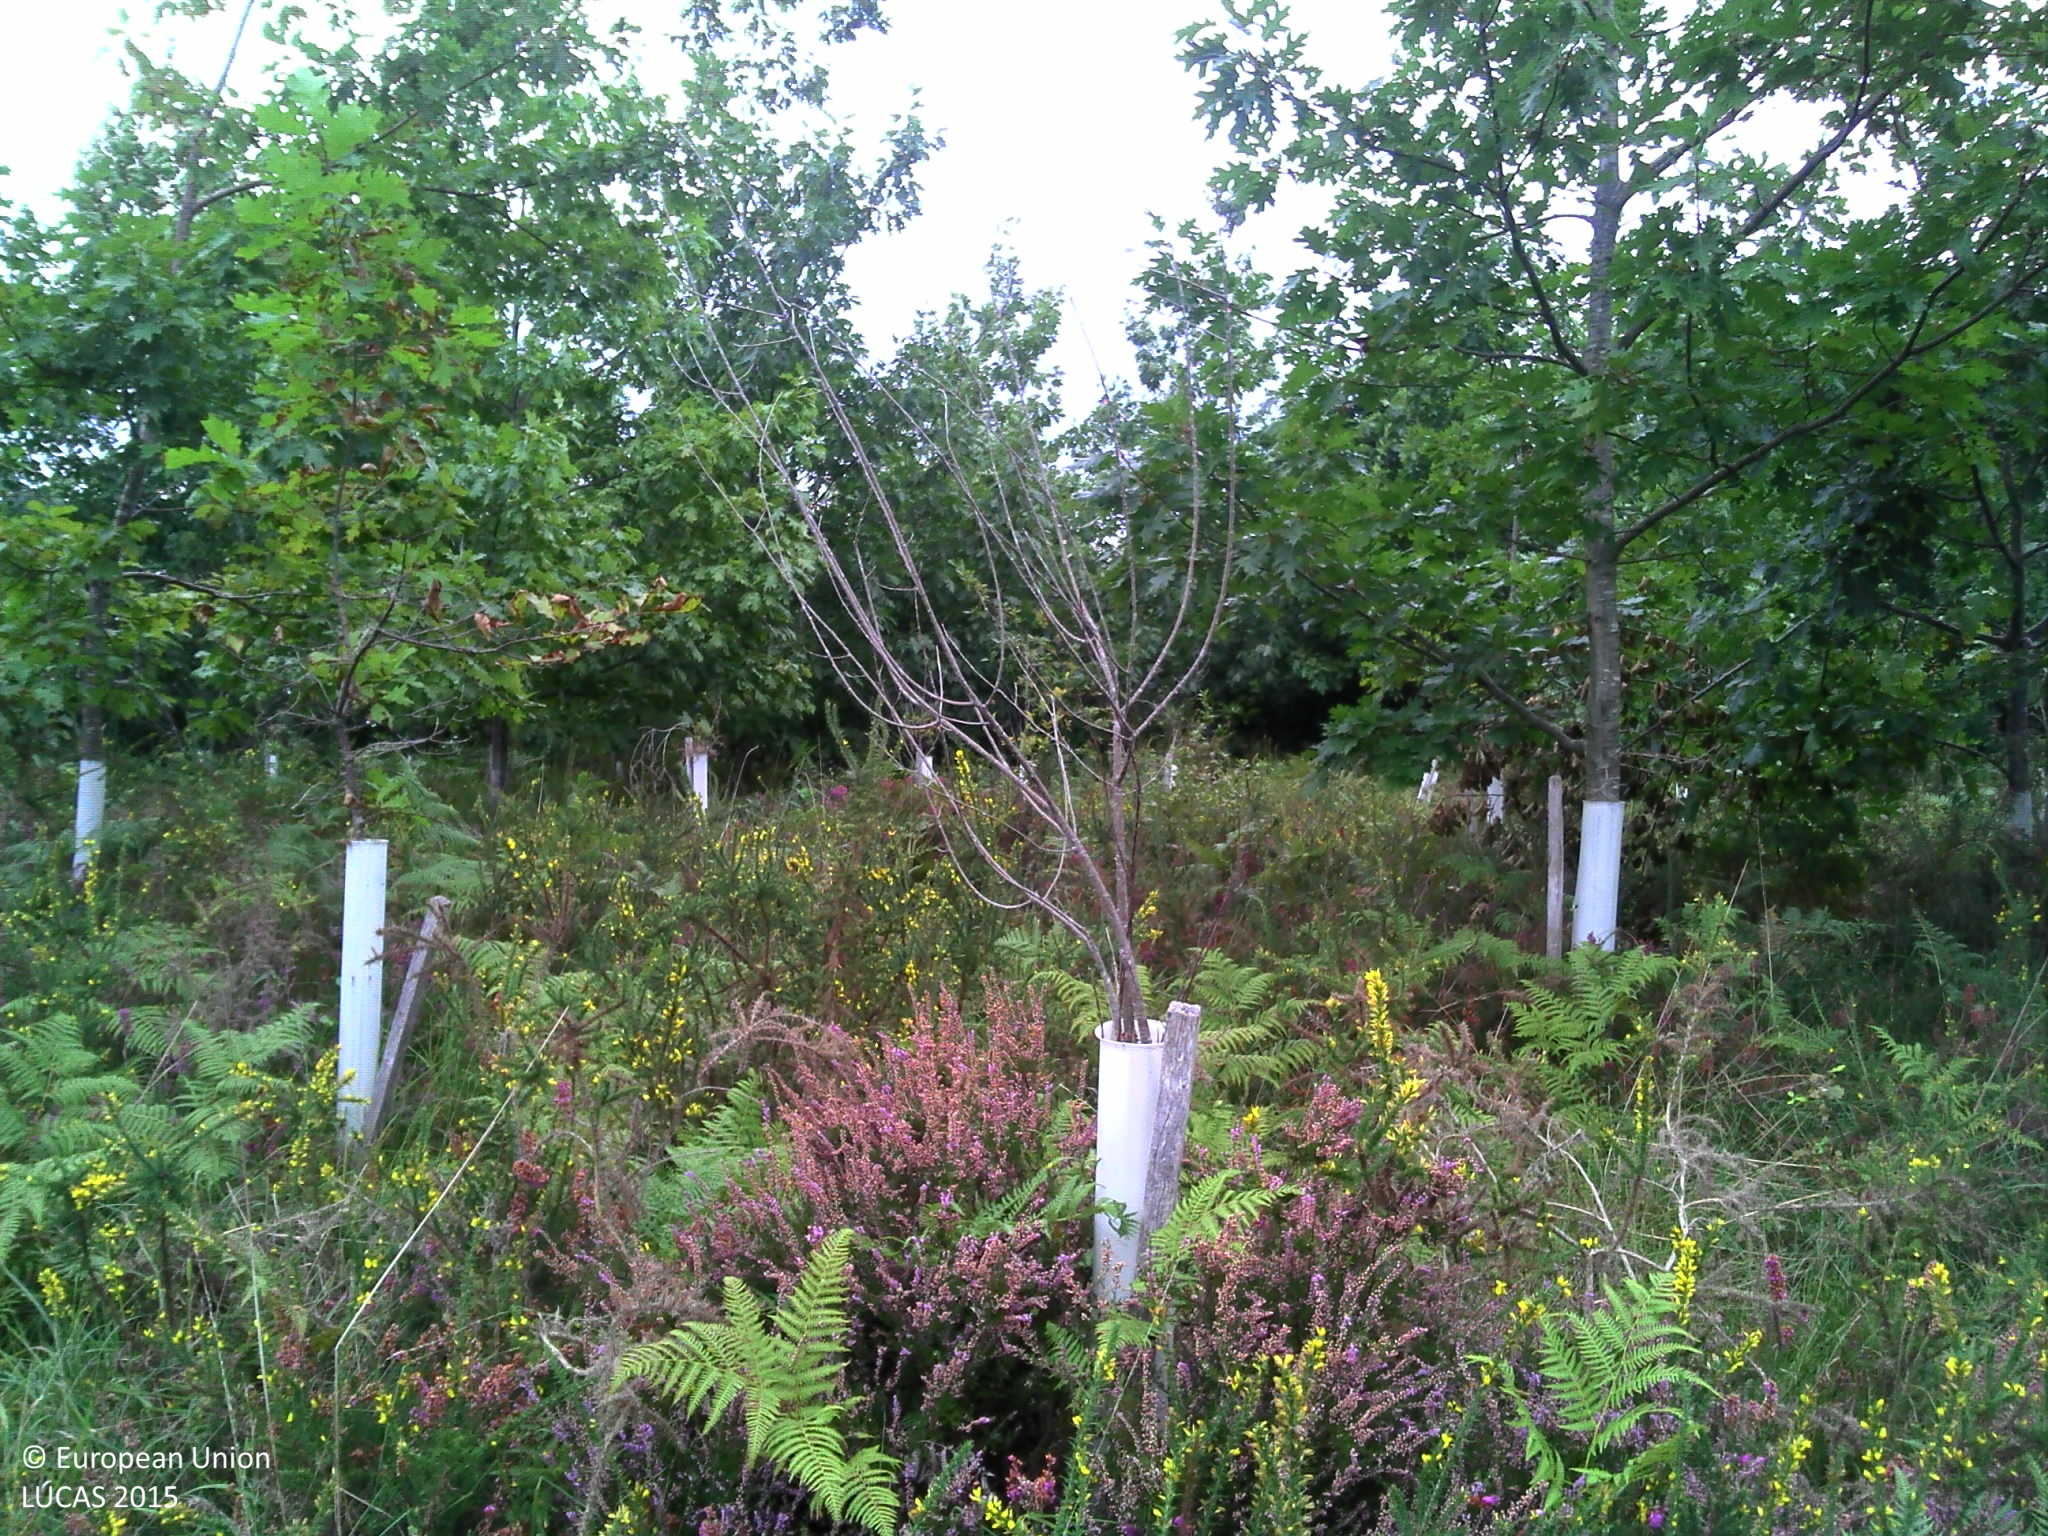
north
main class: Woodland
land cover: Broadleaved woodland
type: exotic forest
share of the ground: 10 - 25 %
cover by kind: shrubs 40 %, herbaceous plants 40 %, broadleaved forest trees 20 %
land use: Forestry
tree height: > 5 m
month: September
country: FR
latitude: 43.3585
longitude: -0.7076
